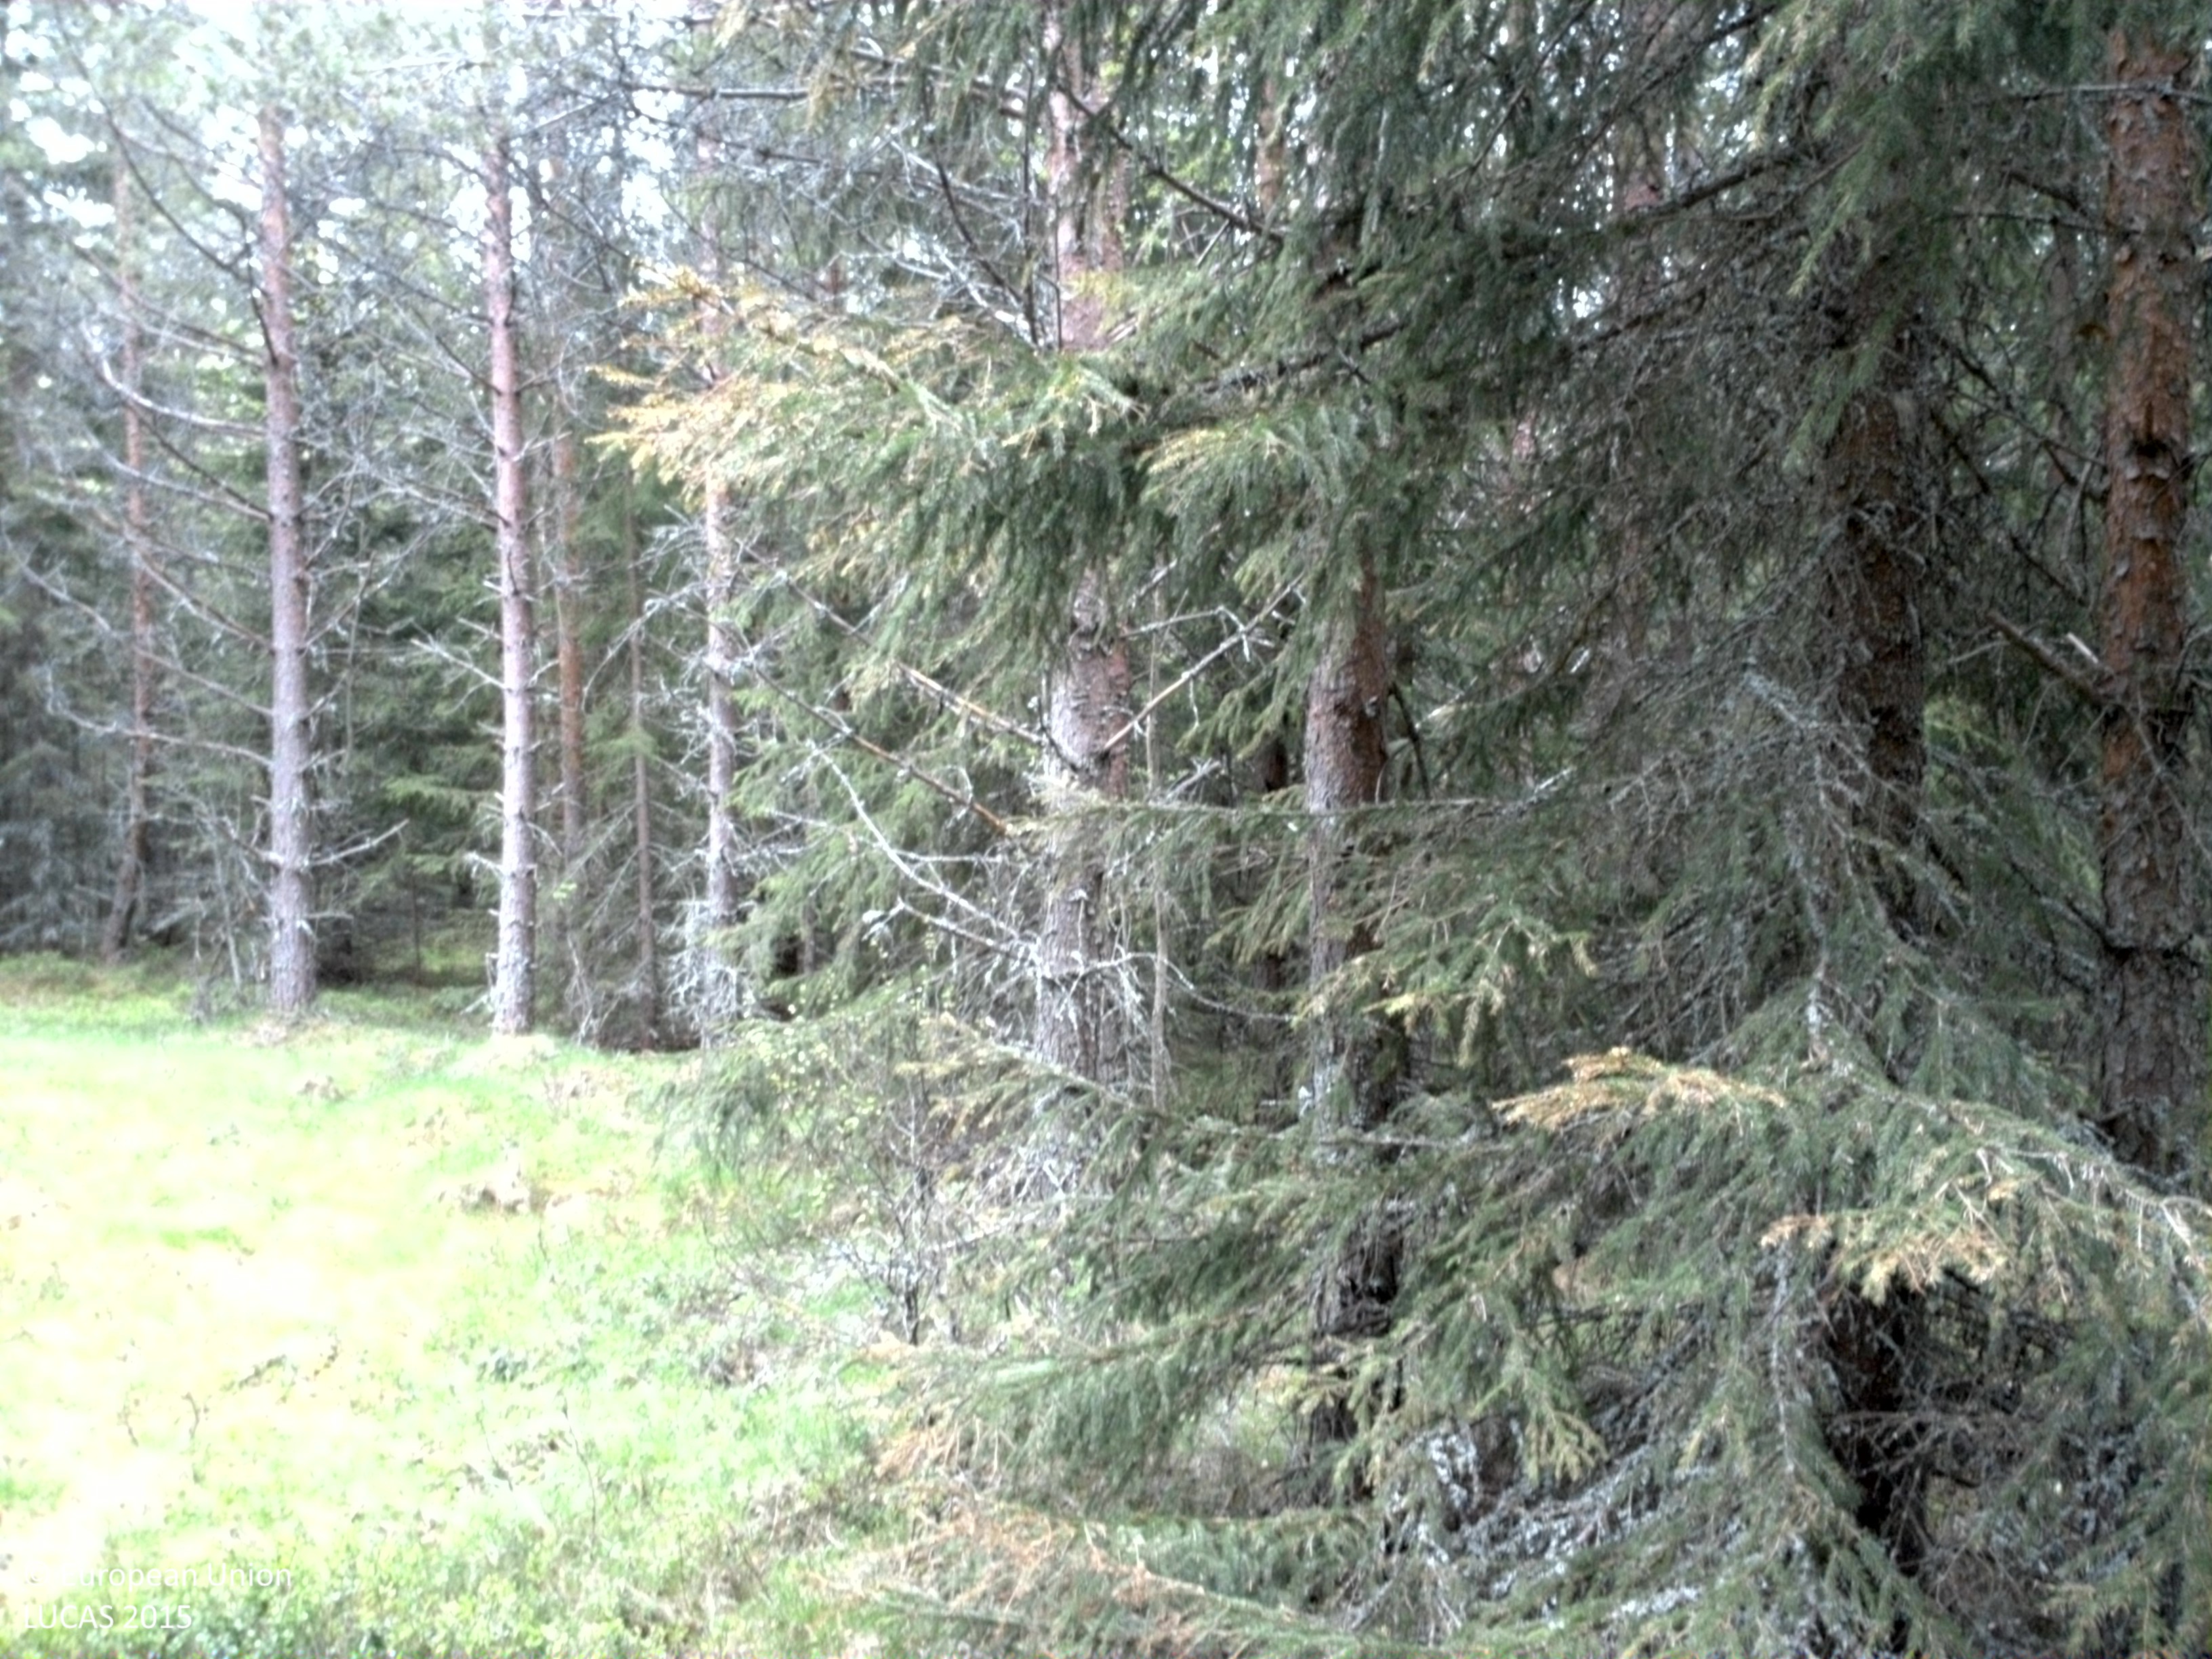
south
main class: Woodland
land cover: Pine dominated coniferous woodland
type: boreal forest
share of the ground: 25 - 50 %
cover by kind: herbaceous plants 65 %, coniferous forest trees 35 %
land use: Forestry
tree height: > 5 m
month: May
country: SE
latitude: 61.1801
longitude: 15.3595
